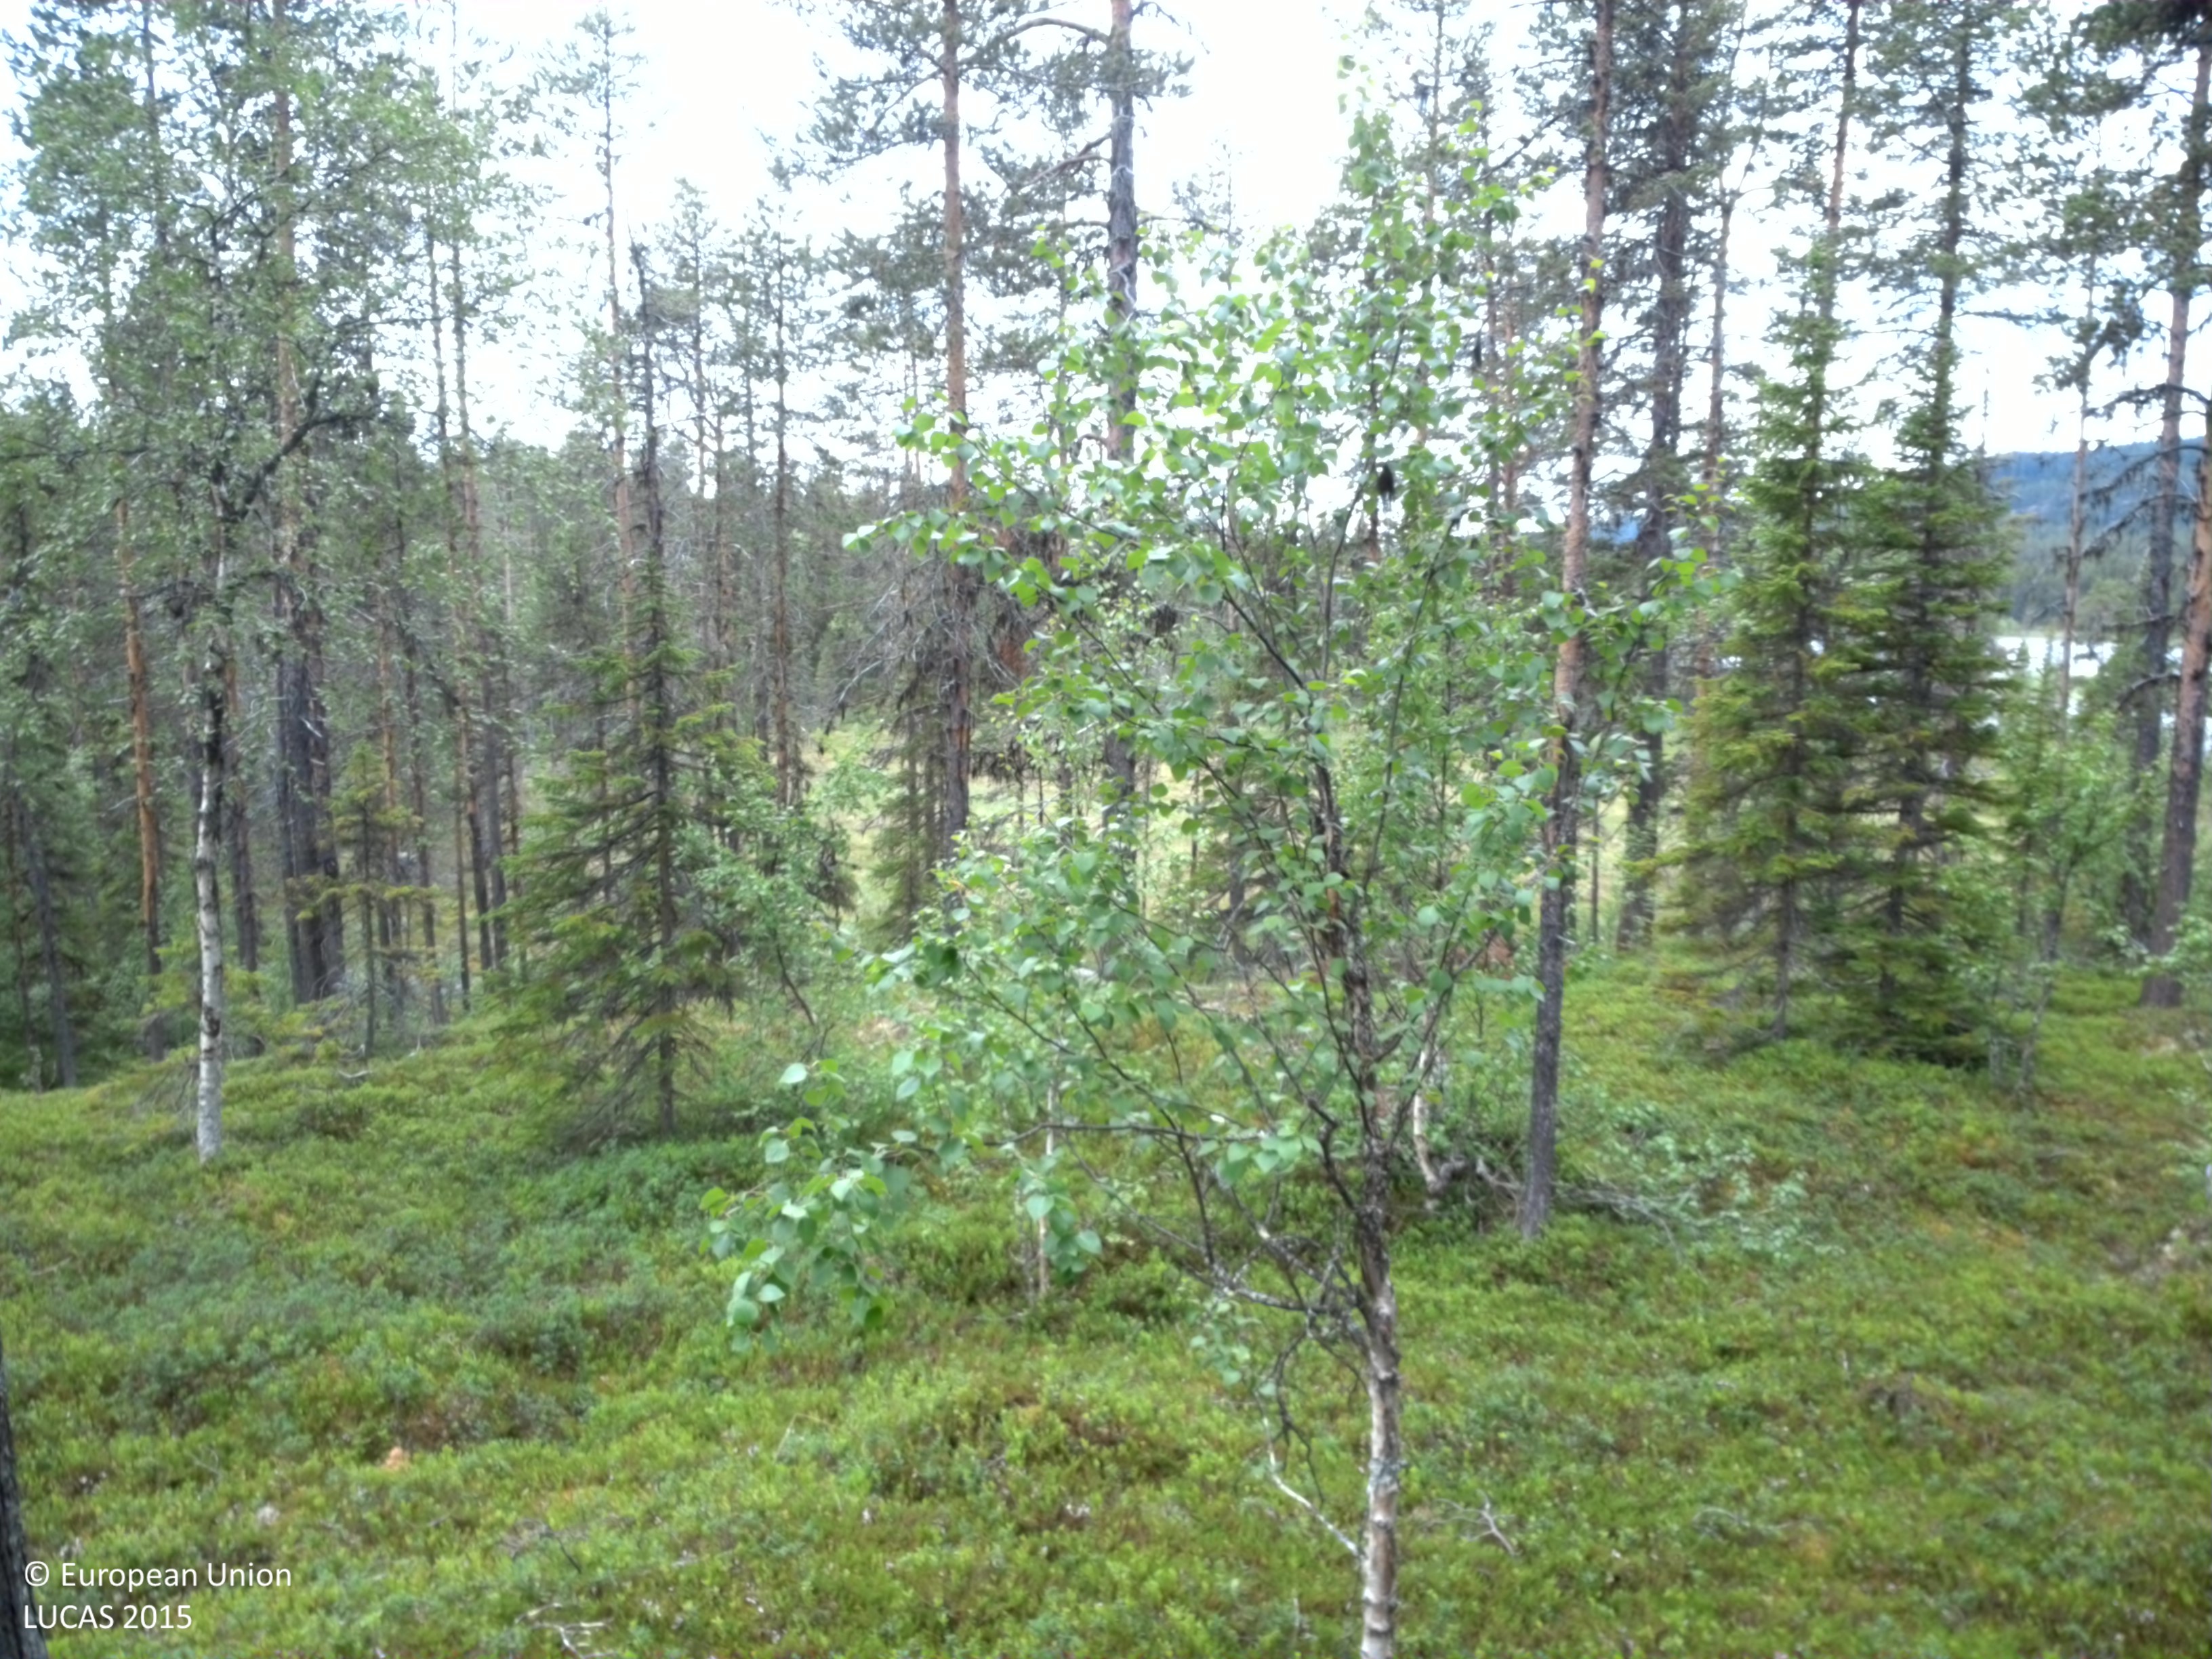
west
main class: Woodland
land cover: Pine dominated mixed woodland
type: boreal forest
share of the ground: 10 - 25 %
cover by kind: shrubs 40 %, lichens and mosses 30 %, coniferous forest trees 20 %, broadleaved forest trees 10 %
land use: Forestry
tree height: > 5 m
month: August
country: SE
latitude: 65.0762
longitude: 16.1538
